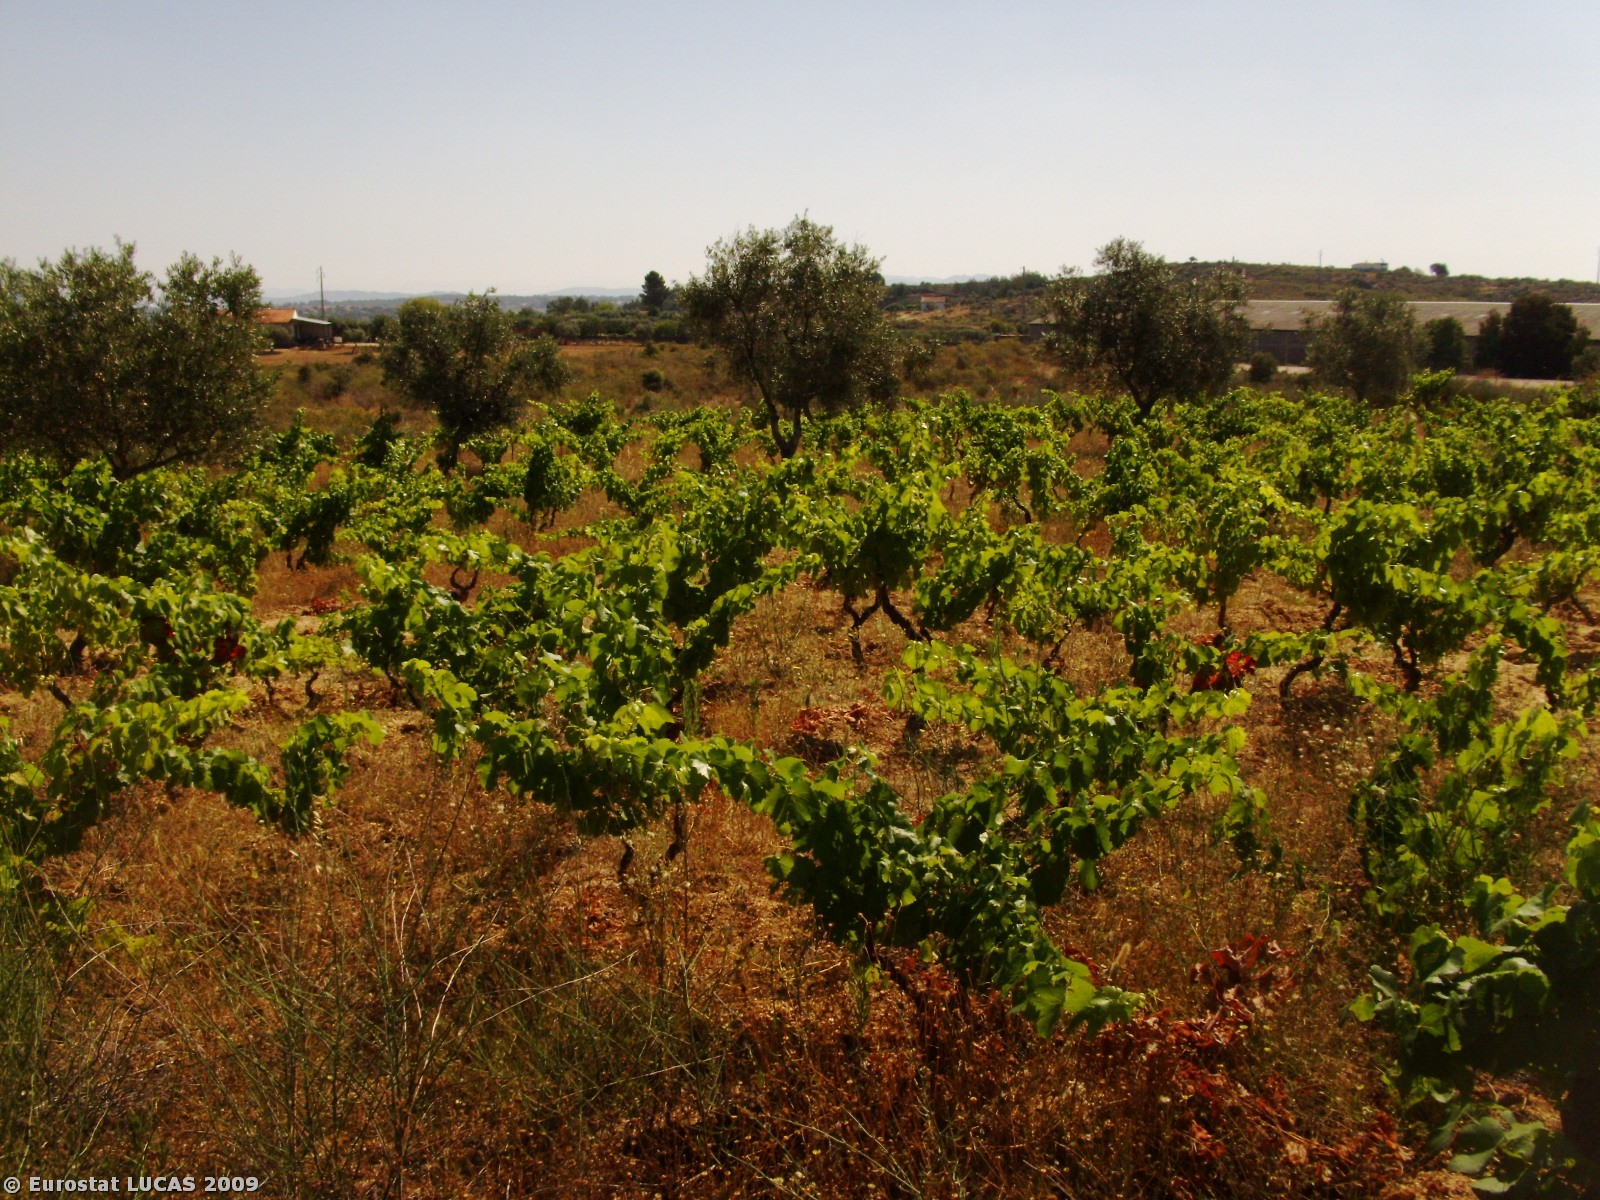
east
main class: Cropland
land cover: Olive groves
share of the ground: 50 - 75 %
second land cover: Spontaneously vegetated surfaces
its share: 25 - 50 %
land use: Agriculture (excluding fallow land and kitchen gardens)
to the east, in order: Olive groves; Spontaneously vegetated surfaces; Olive groves; Fences; Vineyards; Rock outcrops; Vineyards; Fences; Artificial constructions in urban areas; Rock outcrops; Fences; Spontaneously vegetated surfaces; Fences; Spontaneously vegetated surfaces; Artificial constructions; Shruby margins; Tracks; Artificial constructions in urban areas; Spontaneously vegetated surfaces; Artificial constructions in urban areas; Artificial constructions
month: June
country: PT
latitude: 40.0252
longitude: -7.3113
